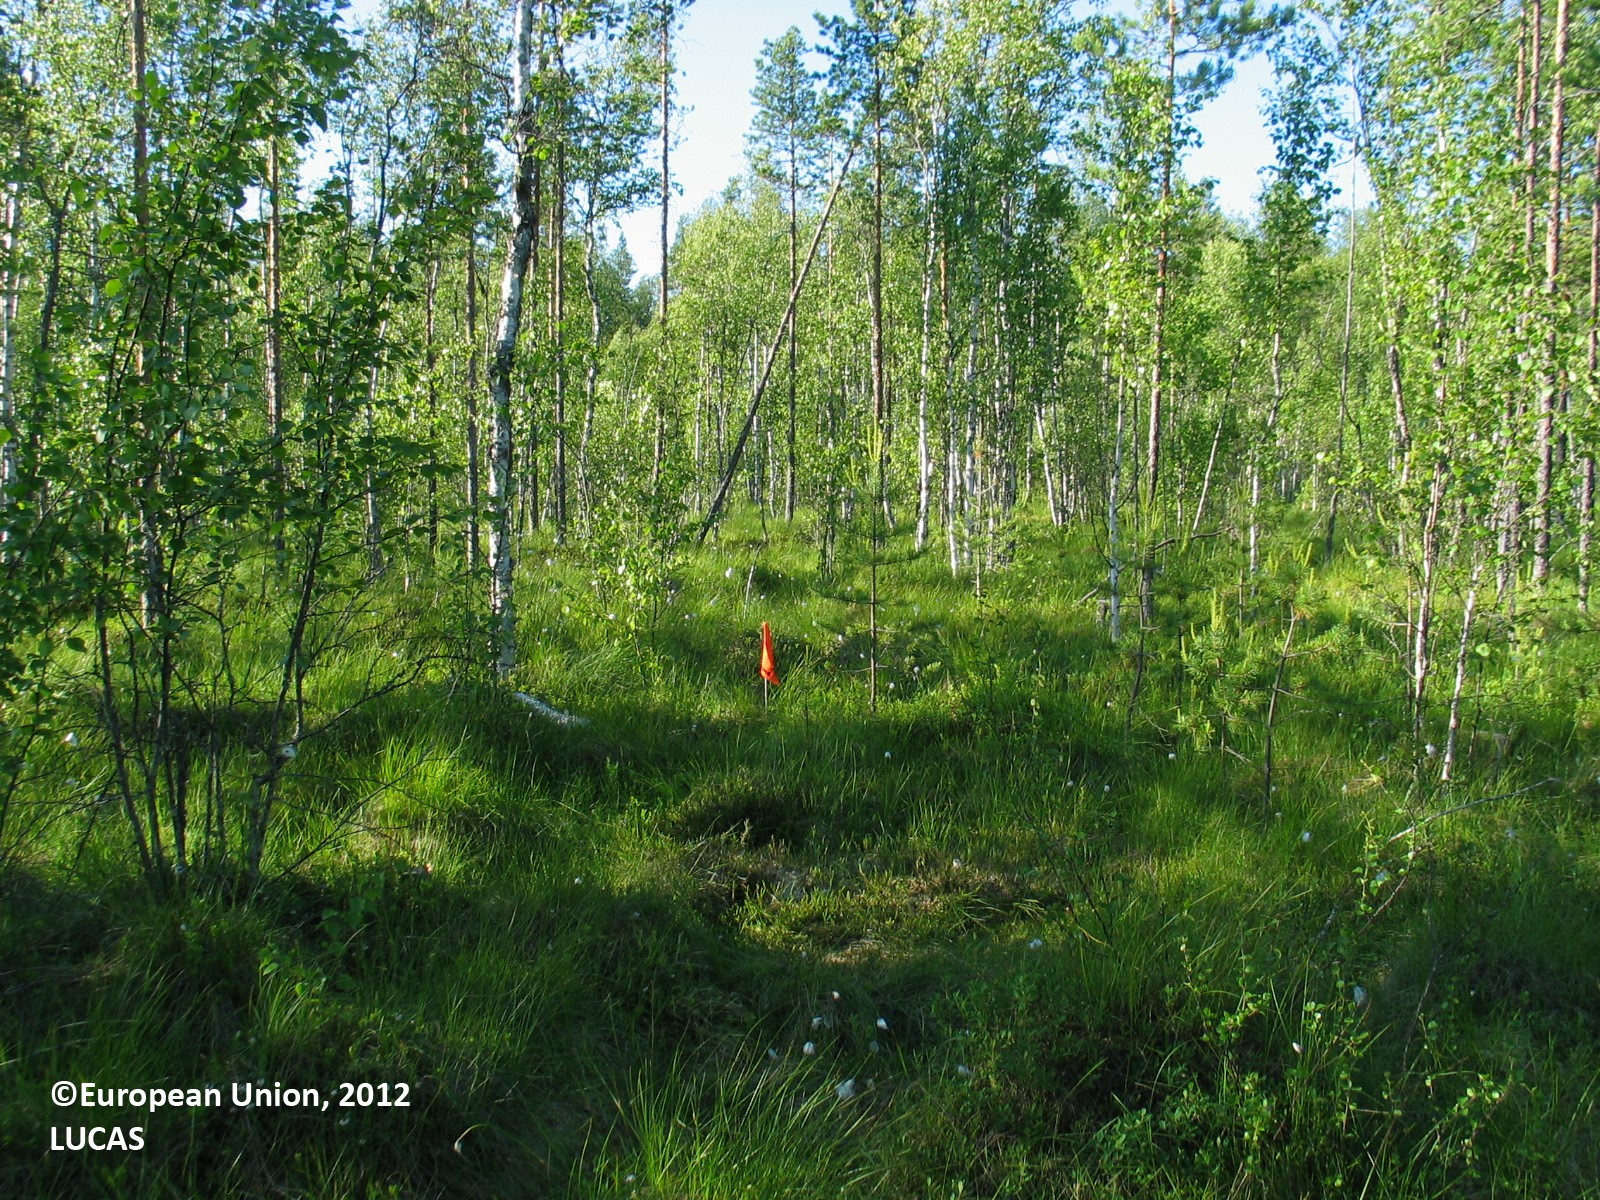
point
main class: Woodland
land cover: Other mixed woodland
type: mire and swamp forests
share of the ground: 10 - 25 %
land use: Forestry
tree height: > 5 m
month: July
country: FI
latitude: 64.7648
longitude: 26.5302
